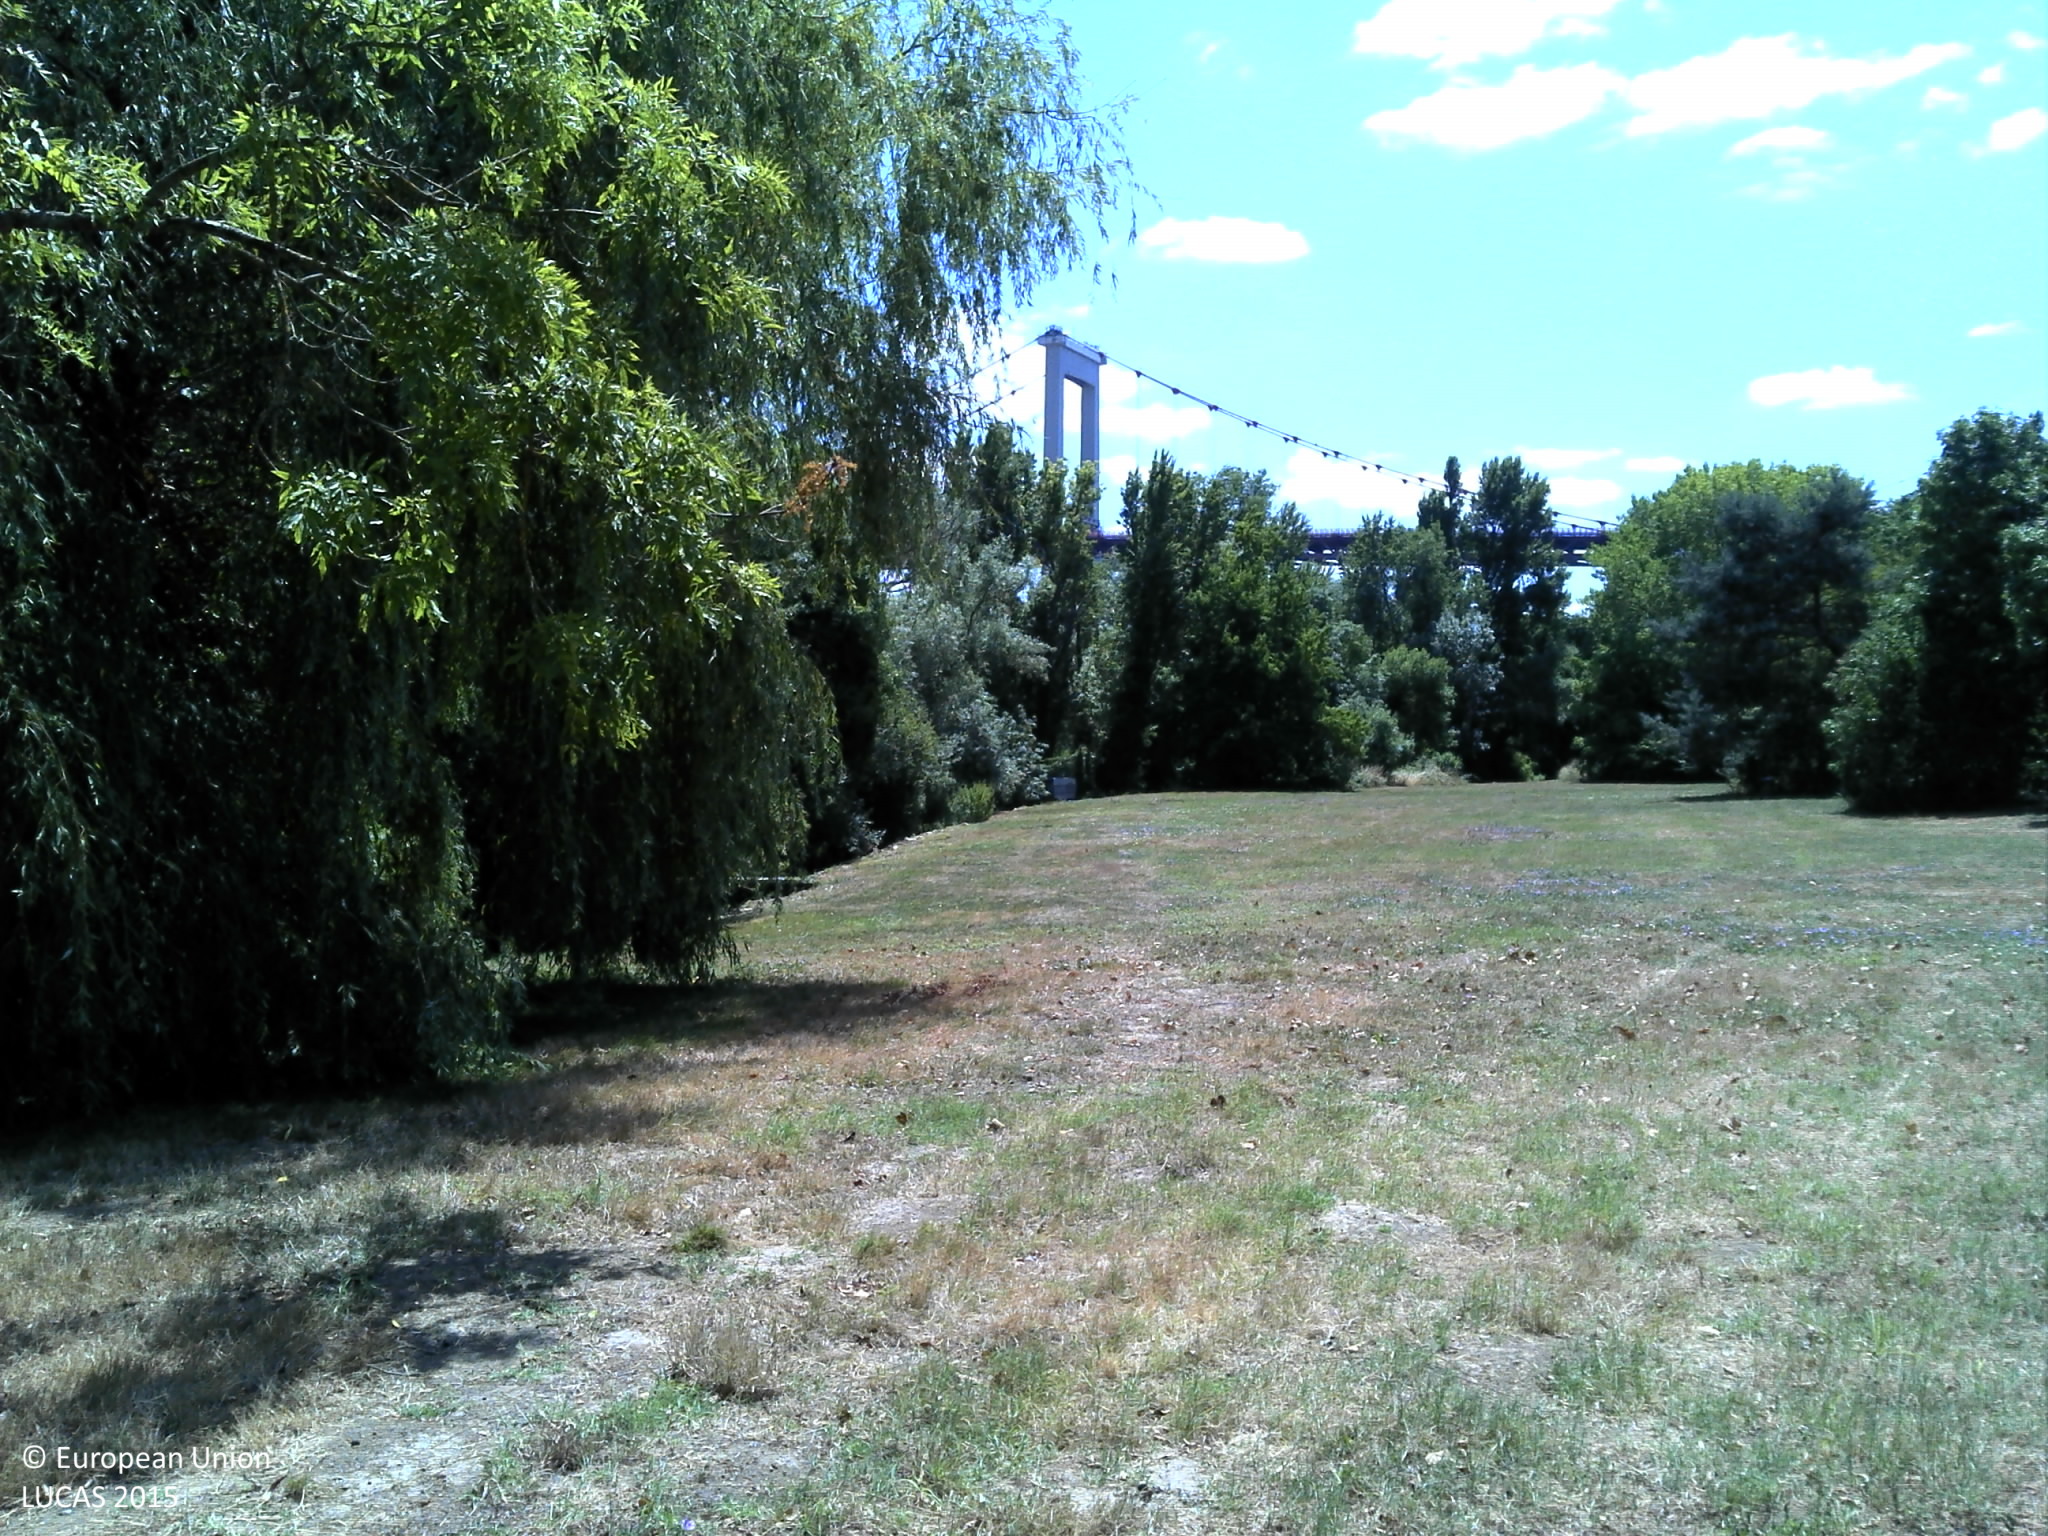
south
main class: Grassland
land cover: Grassland without tree/shrub cover
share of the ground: > 75 %
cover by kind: herbaceous plants 100 %
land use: Amenities, museums, leisure
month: July
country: FR
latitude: 44.8846
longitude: -0.5393
